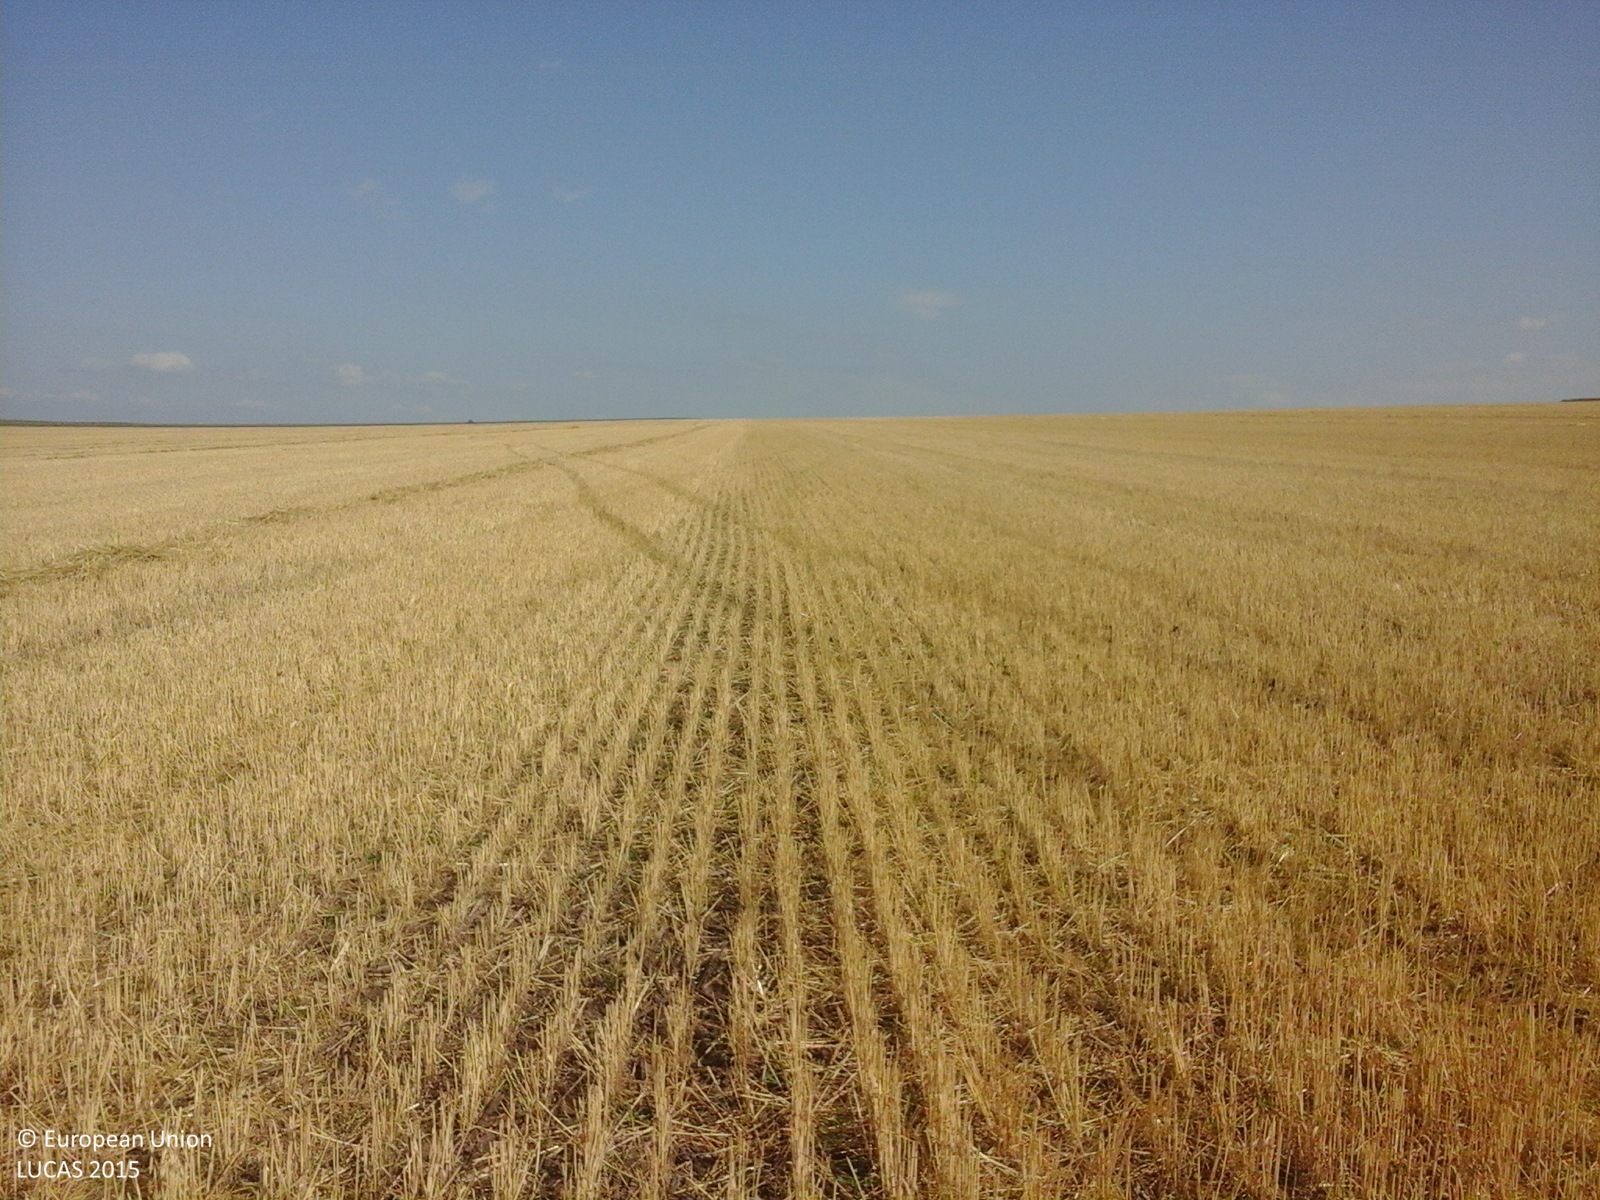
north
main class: Cropland
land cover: Common wheat
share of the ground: > 75 %
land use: Agriculture (excluding fallow land and kitchen gardens)
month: July
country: RO
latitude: 46.3747
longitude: 28.1085
